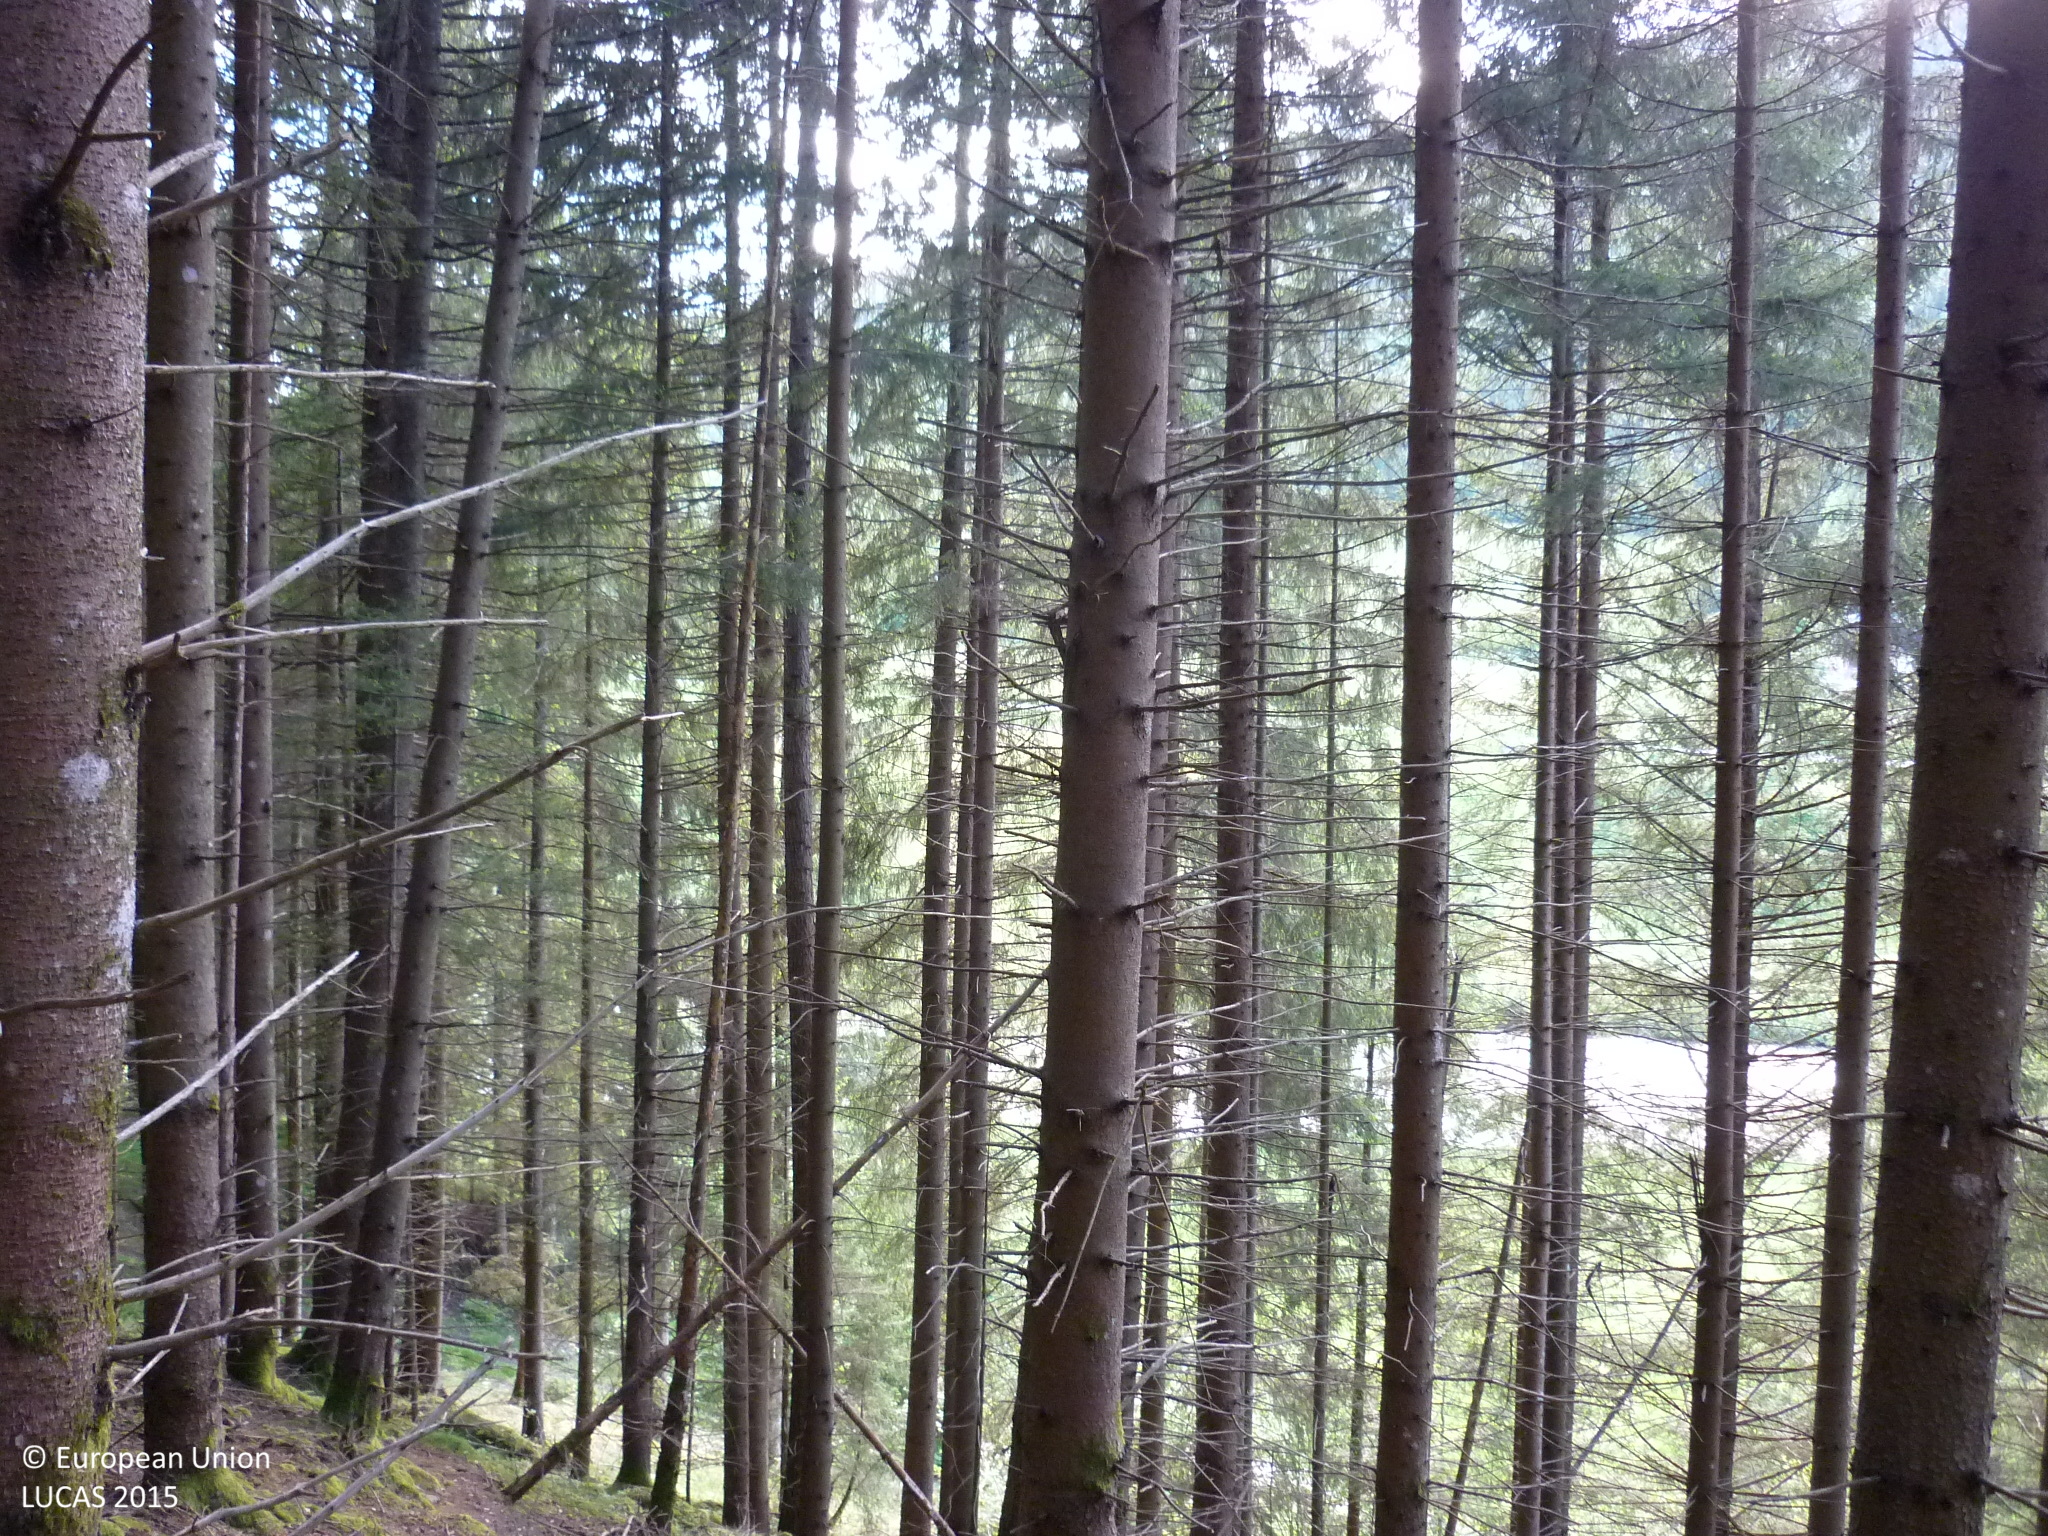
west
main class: Woodland
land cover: Spruce dominated coniferous woodland
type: alpine coniferous forest
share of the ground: > 75 %
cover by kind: coniferous forest trees 90 %, herbaceous plants 5 %, lichens and mosses 5 %
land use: Forestry
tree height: > 5 m
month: May
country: AT
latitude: 47.1052
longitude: 14.0170
